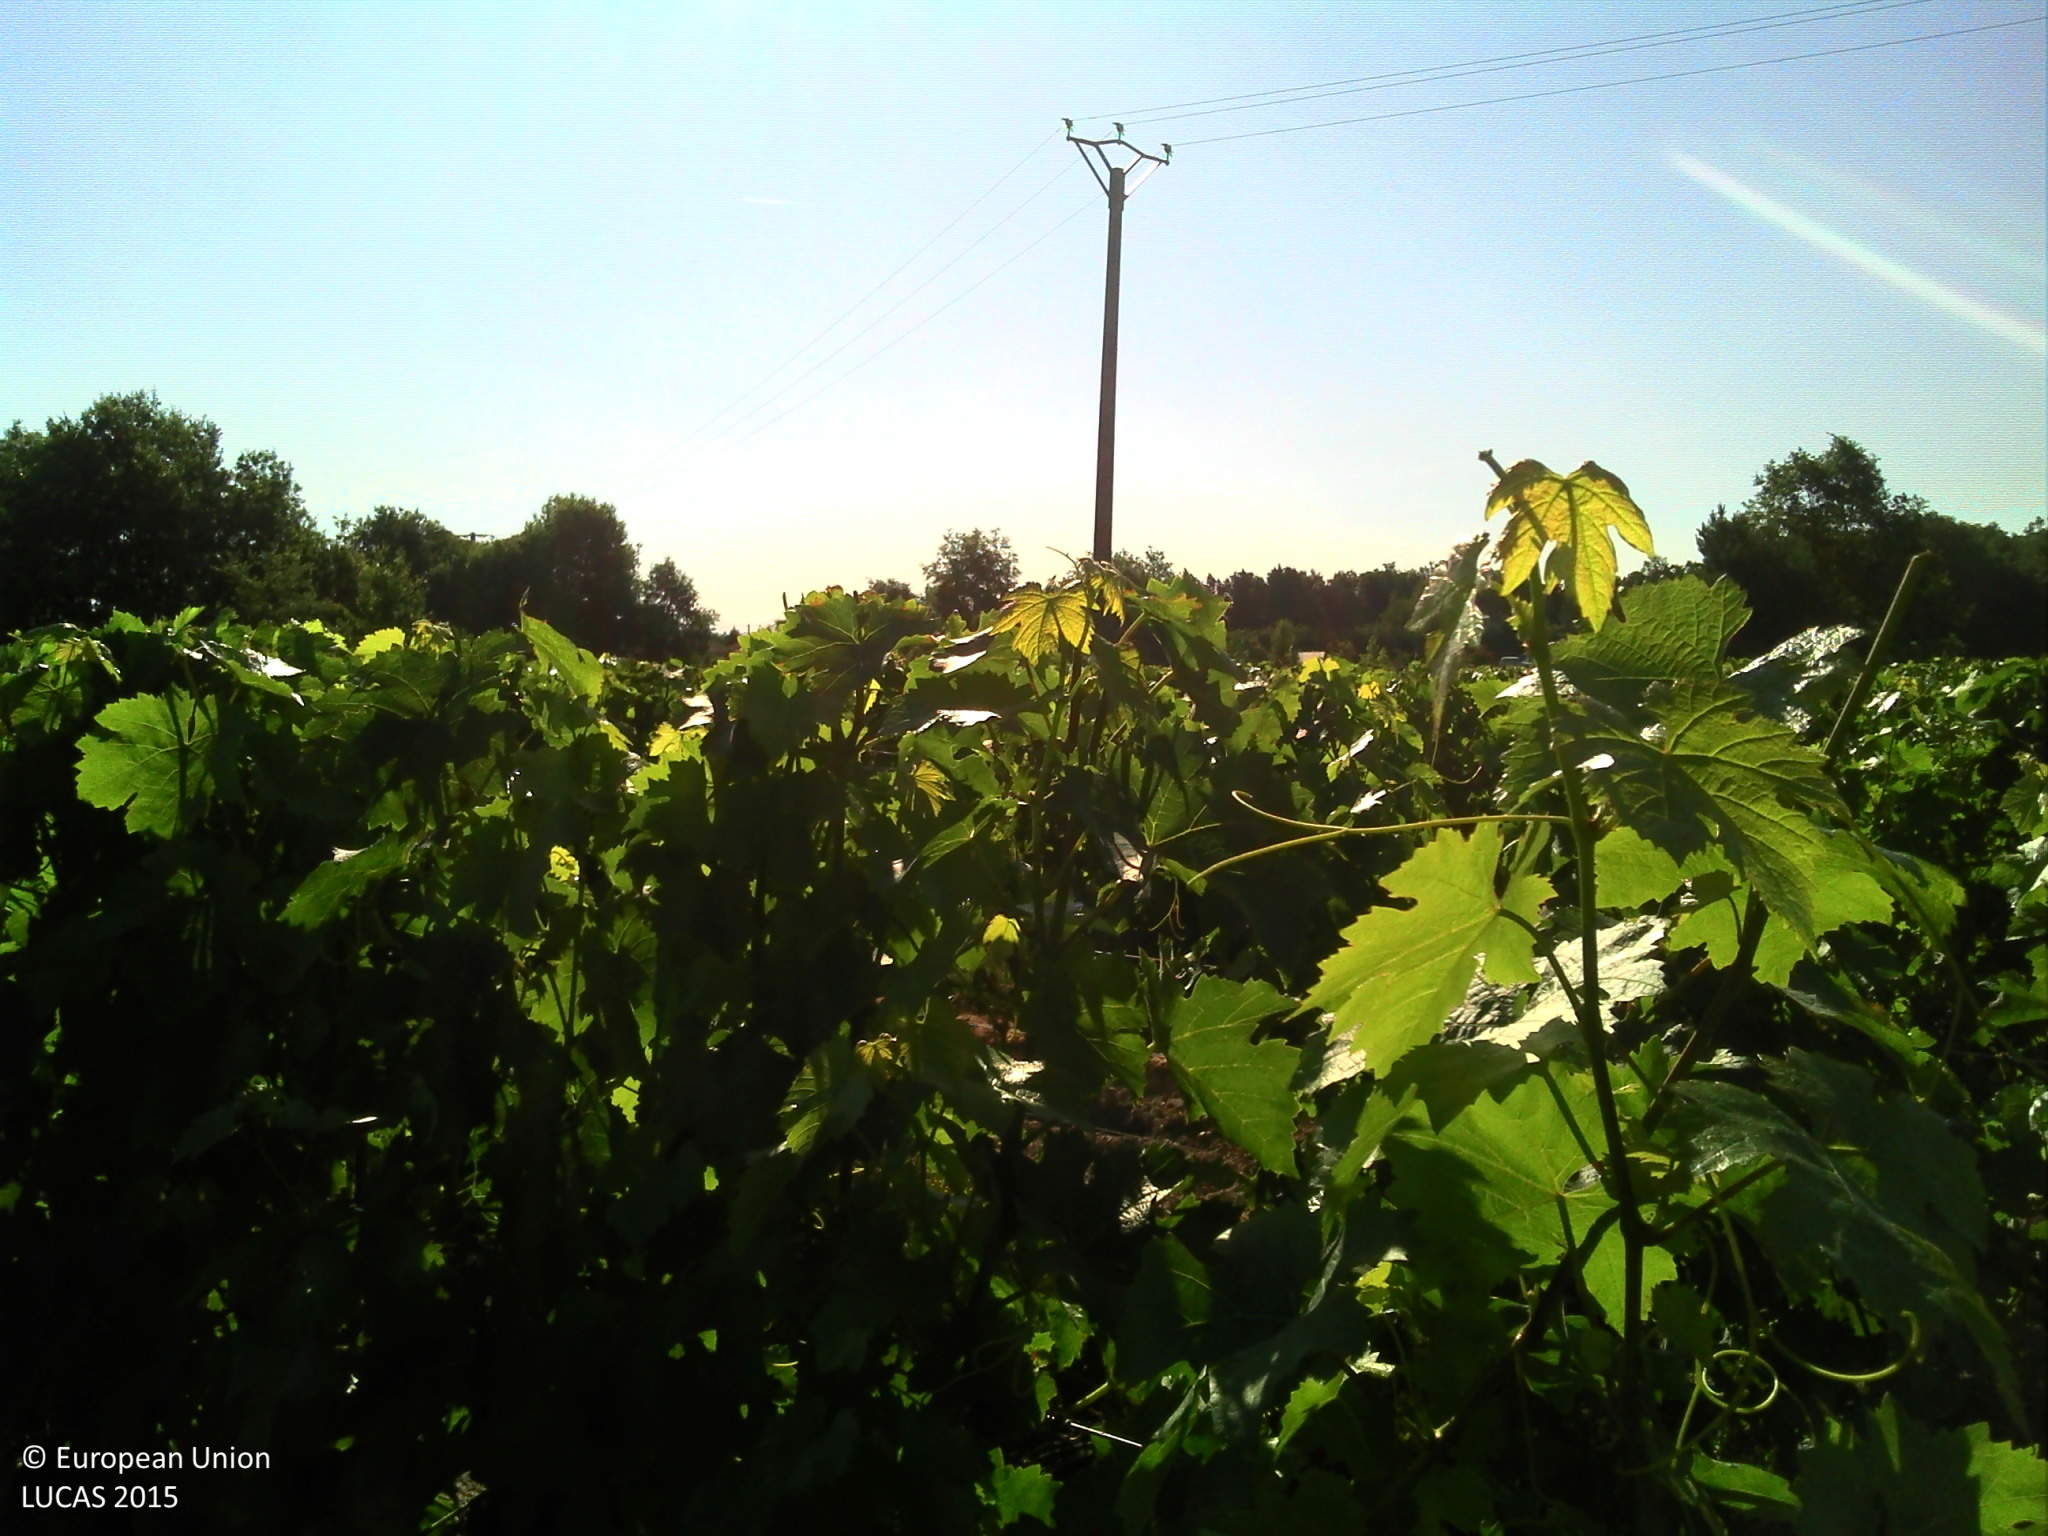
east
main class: Cropland
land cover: Vineyards
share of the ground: > 75 %
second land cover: Grassland without tree/shrub cover
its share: > 75 %
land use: Agriculture (excluding fallow land and kitchen gardens)
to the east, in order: Vineyards; Grassland without tree/shrub cover; Grass margins; Ditches and canals; Grass margins; Tracks; Grass margins; Grassland without tree/shrub cover; Artificial constructions in urban areas
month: June
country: FR
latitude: 43.8643
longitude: 1.3782
